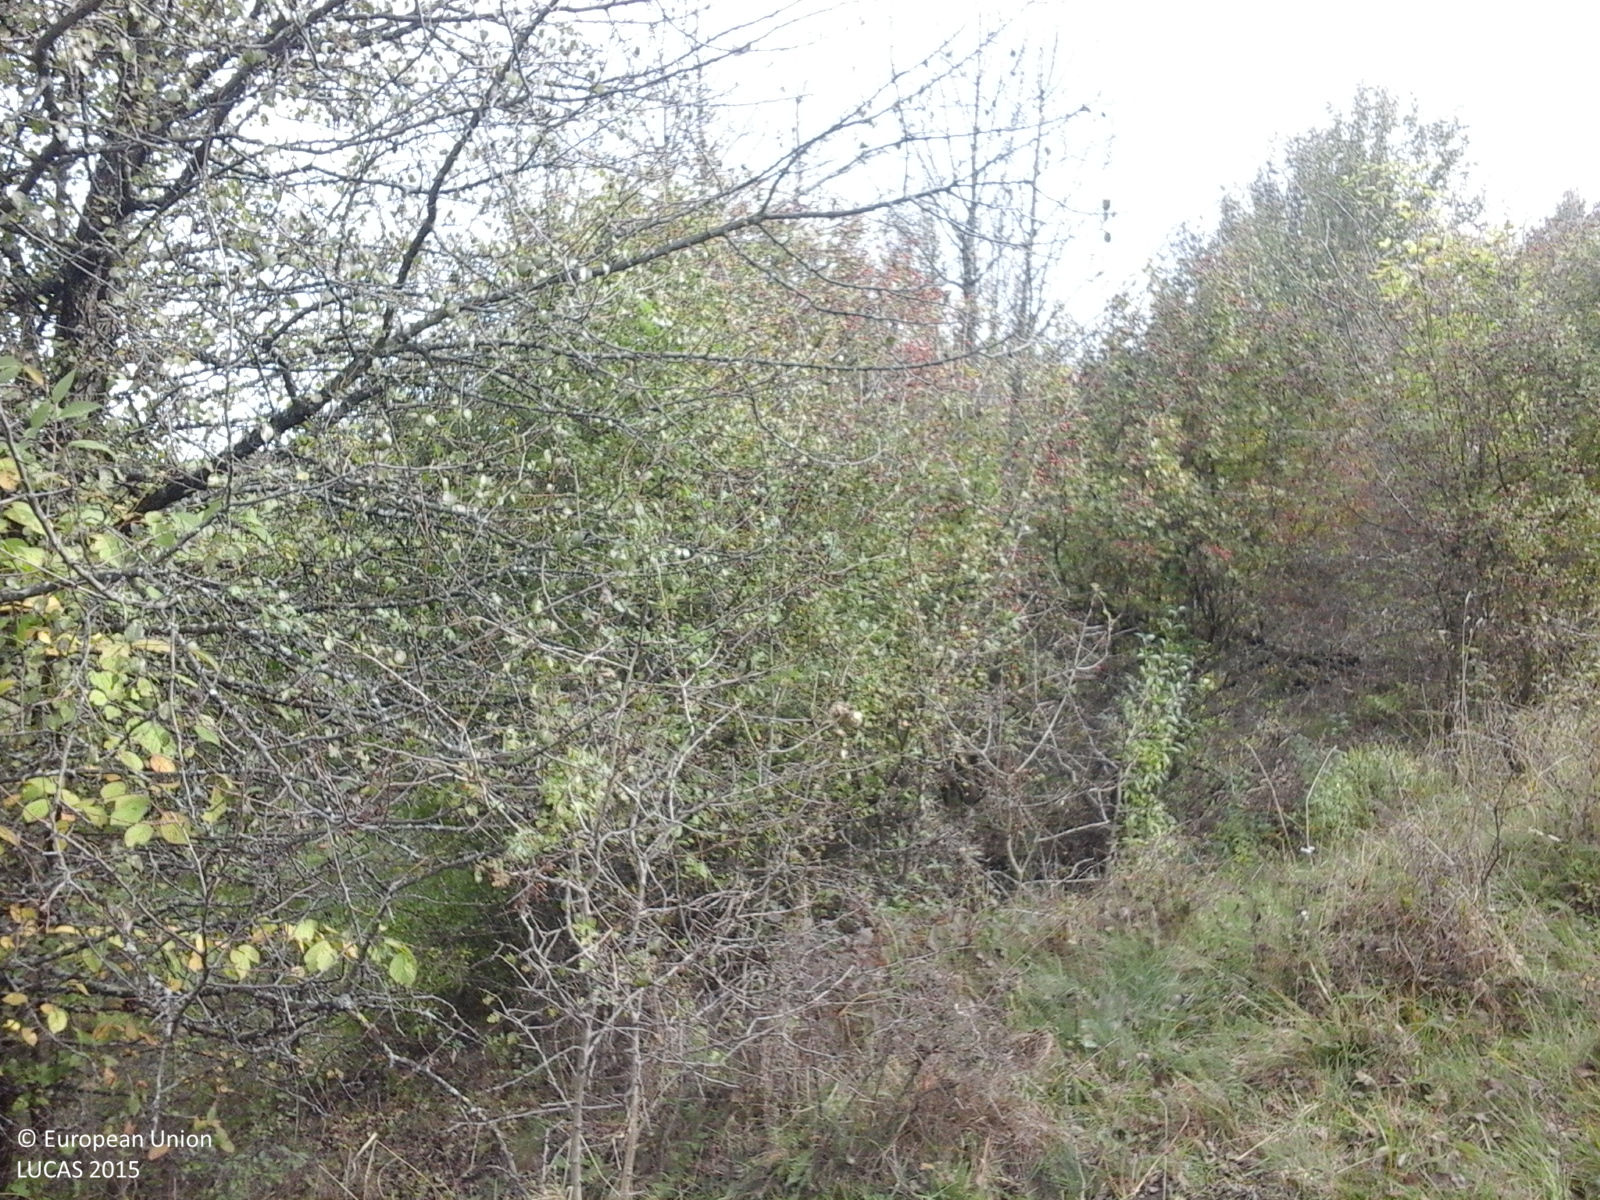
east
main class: Shrubland
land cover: Shrubland with sparse tree cover
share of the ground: > 75 %
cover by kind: herbaceous plants 60 %, shrubs 35 %, broadleaved forest trees 5 %
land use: Fallow land
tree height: < 5 m
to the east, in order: Shrubland with sparse tree cover; Grassland without tree/shrub cover; Tracks; Grassland without tree/shrub cover
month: October
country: RO
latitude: 46.2548
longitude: 25.2659
